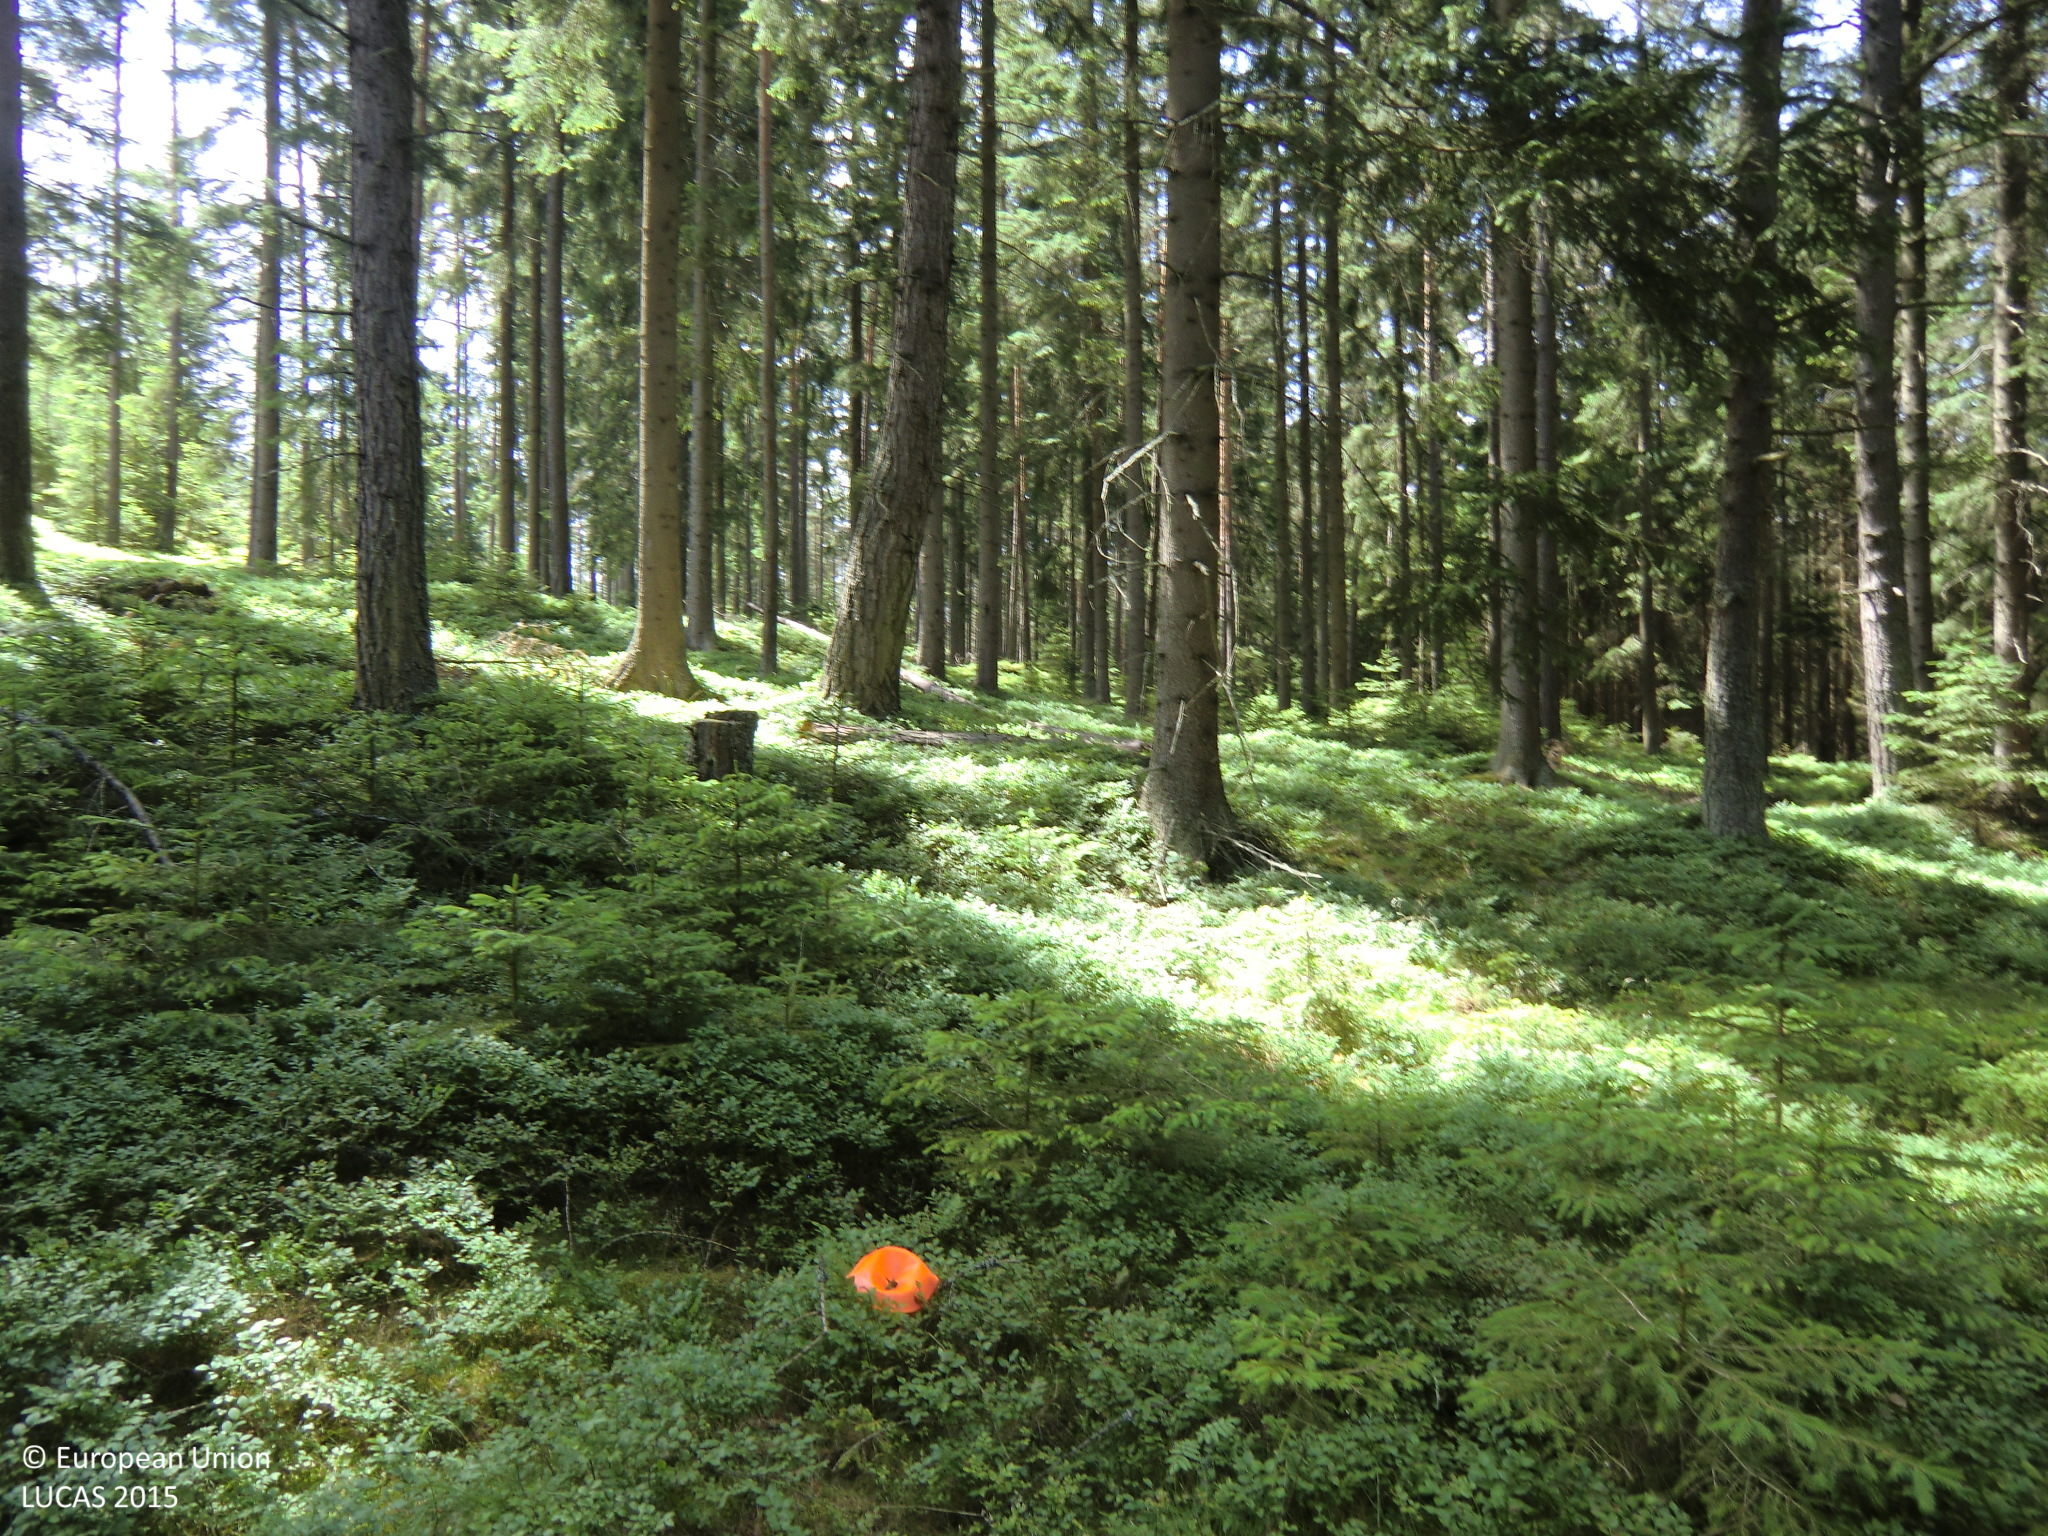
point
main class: Woodland
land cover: Spruce dominated coniferous woodland
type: hemiboreal forest and nemoral coniferous forest and mixed broadleaved-coniferous forest
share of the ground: > 75 %
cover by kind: coniferous forest trees 75 %, shrubs 20 %, herbaceous plants 5 %
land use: Forestry
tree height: > 5 m
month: June
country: AT
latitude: 48.5236
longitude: 15.0250
